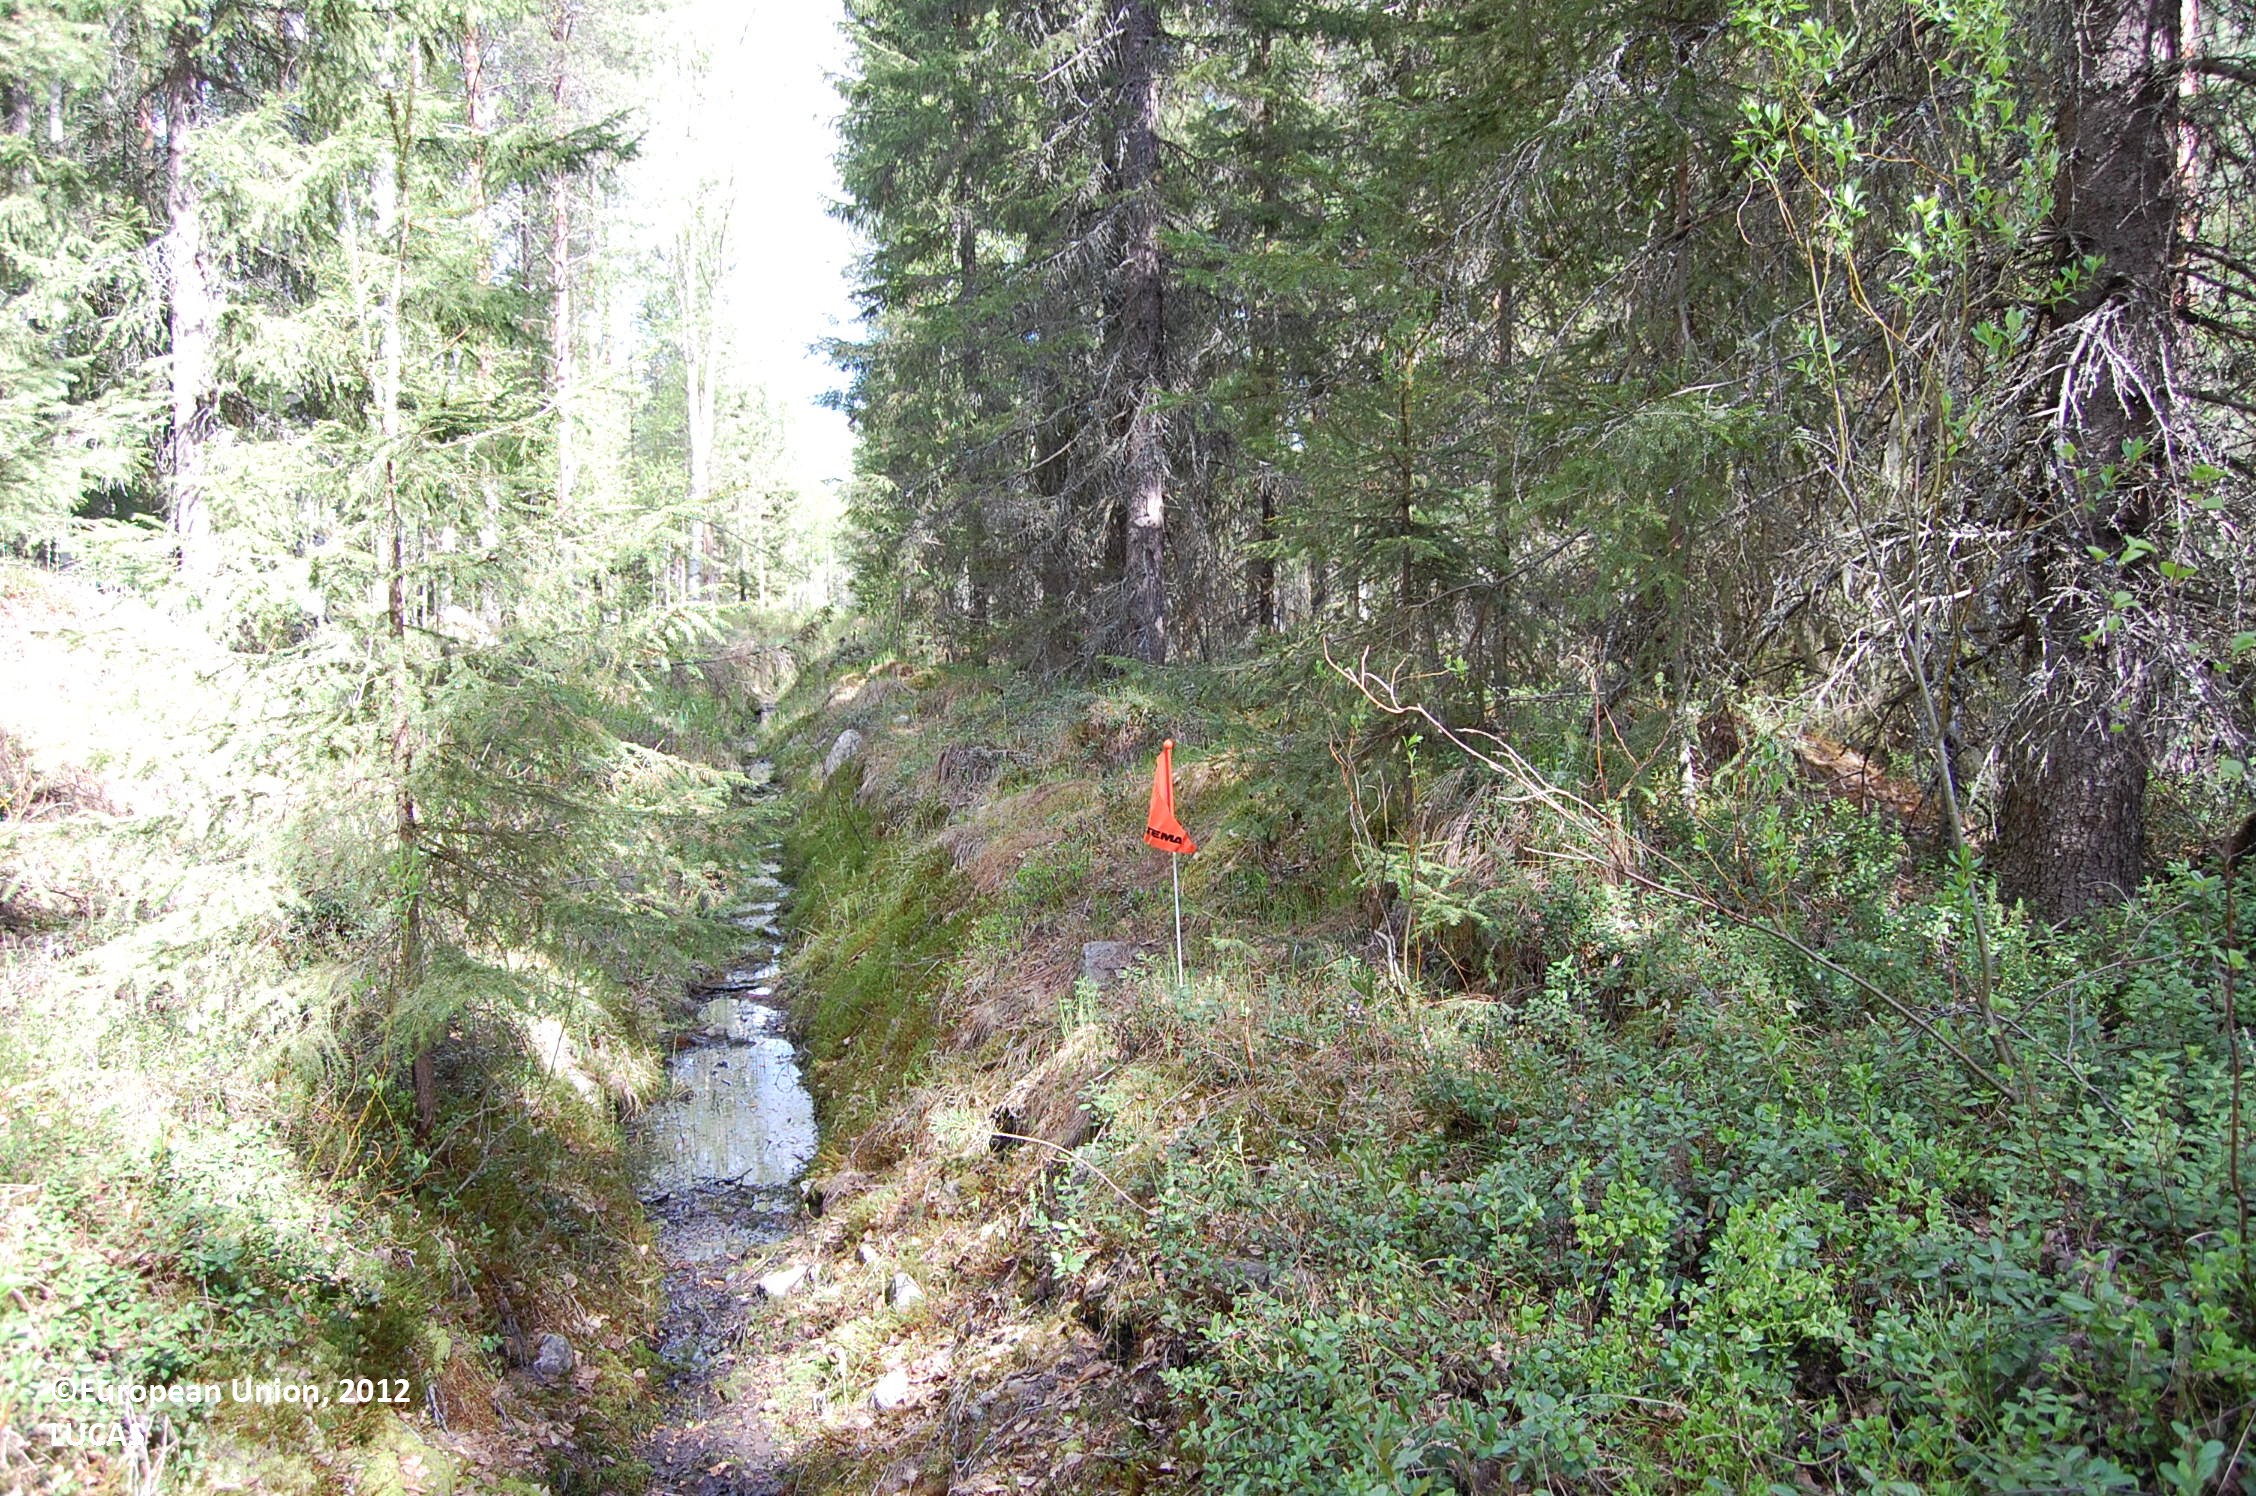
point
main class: Woodland
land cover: Other mixed woodland
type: boreal forest
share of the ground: > 75 %
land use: Forestry
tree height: > 5 m
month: May
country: FI
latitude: 64.2933
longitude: 26.2480
